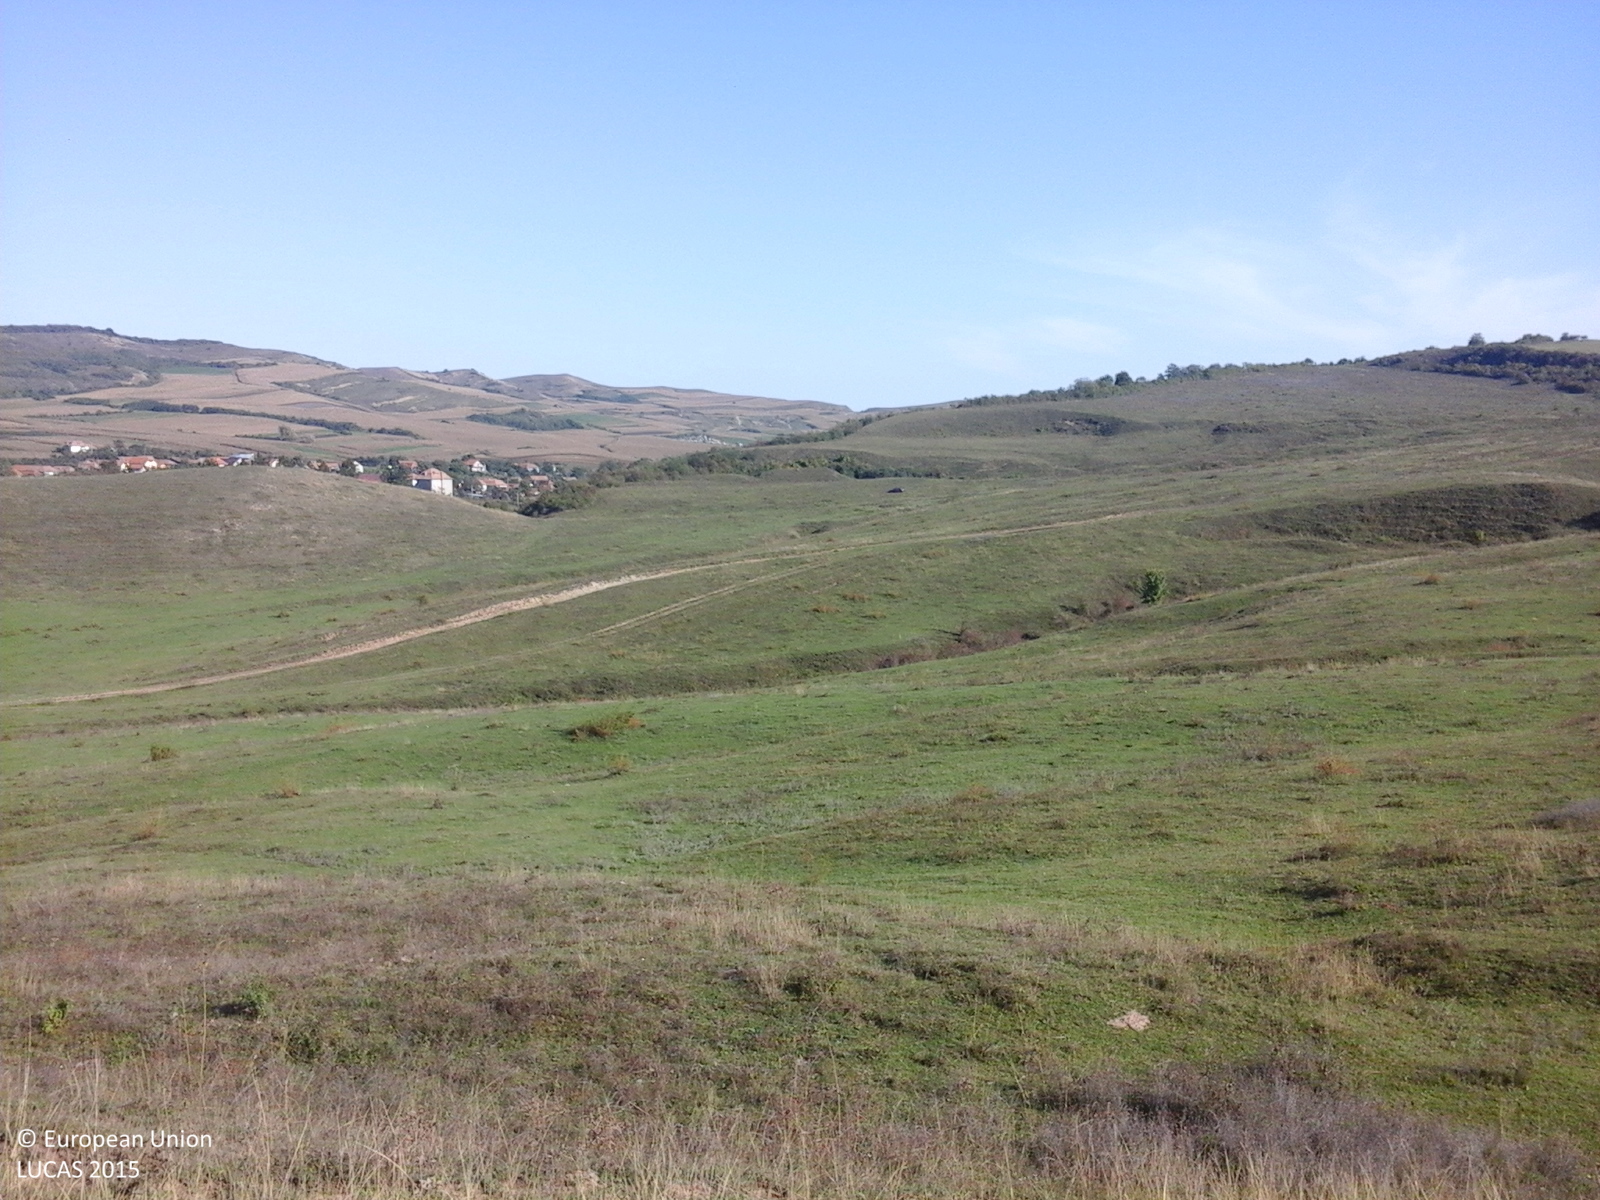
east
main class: Grassland
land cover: Grassland without tree/shrub cover
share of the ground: > 75 %
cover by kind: herbaceous plants 100 %
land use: Agriculture (excluding fallow land and kitchen gardens)
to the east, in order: Grassland without tree/shrub cover; Ditches and canals; Grassland without tree/shrub cover; Tracks; Grassland without tree/shrub cover
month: October
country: RO
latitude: 46.2859
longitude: 23.8437
